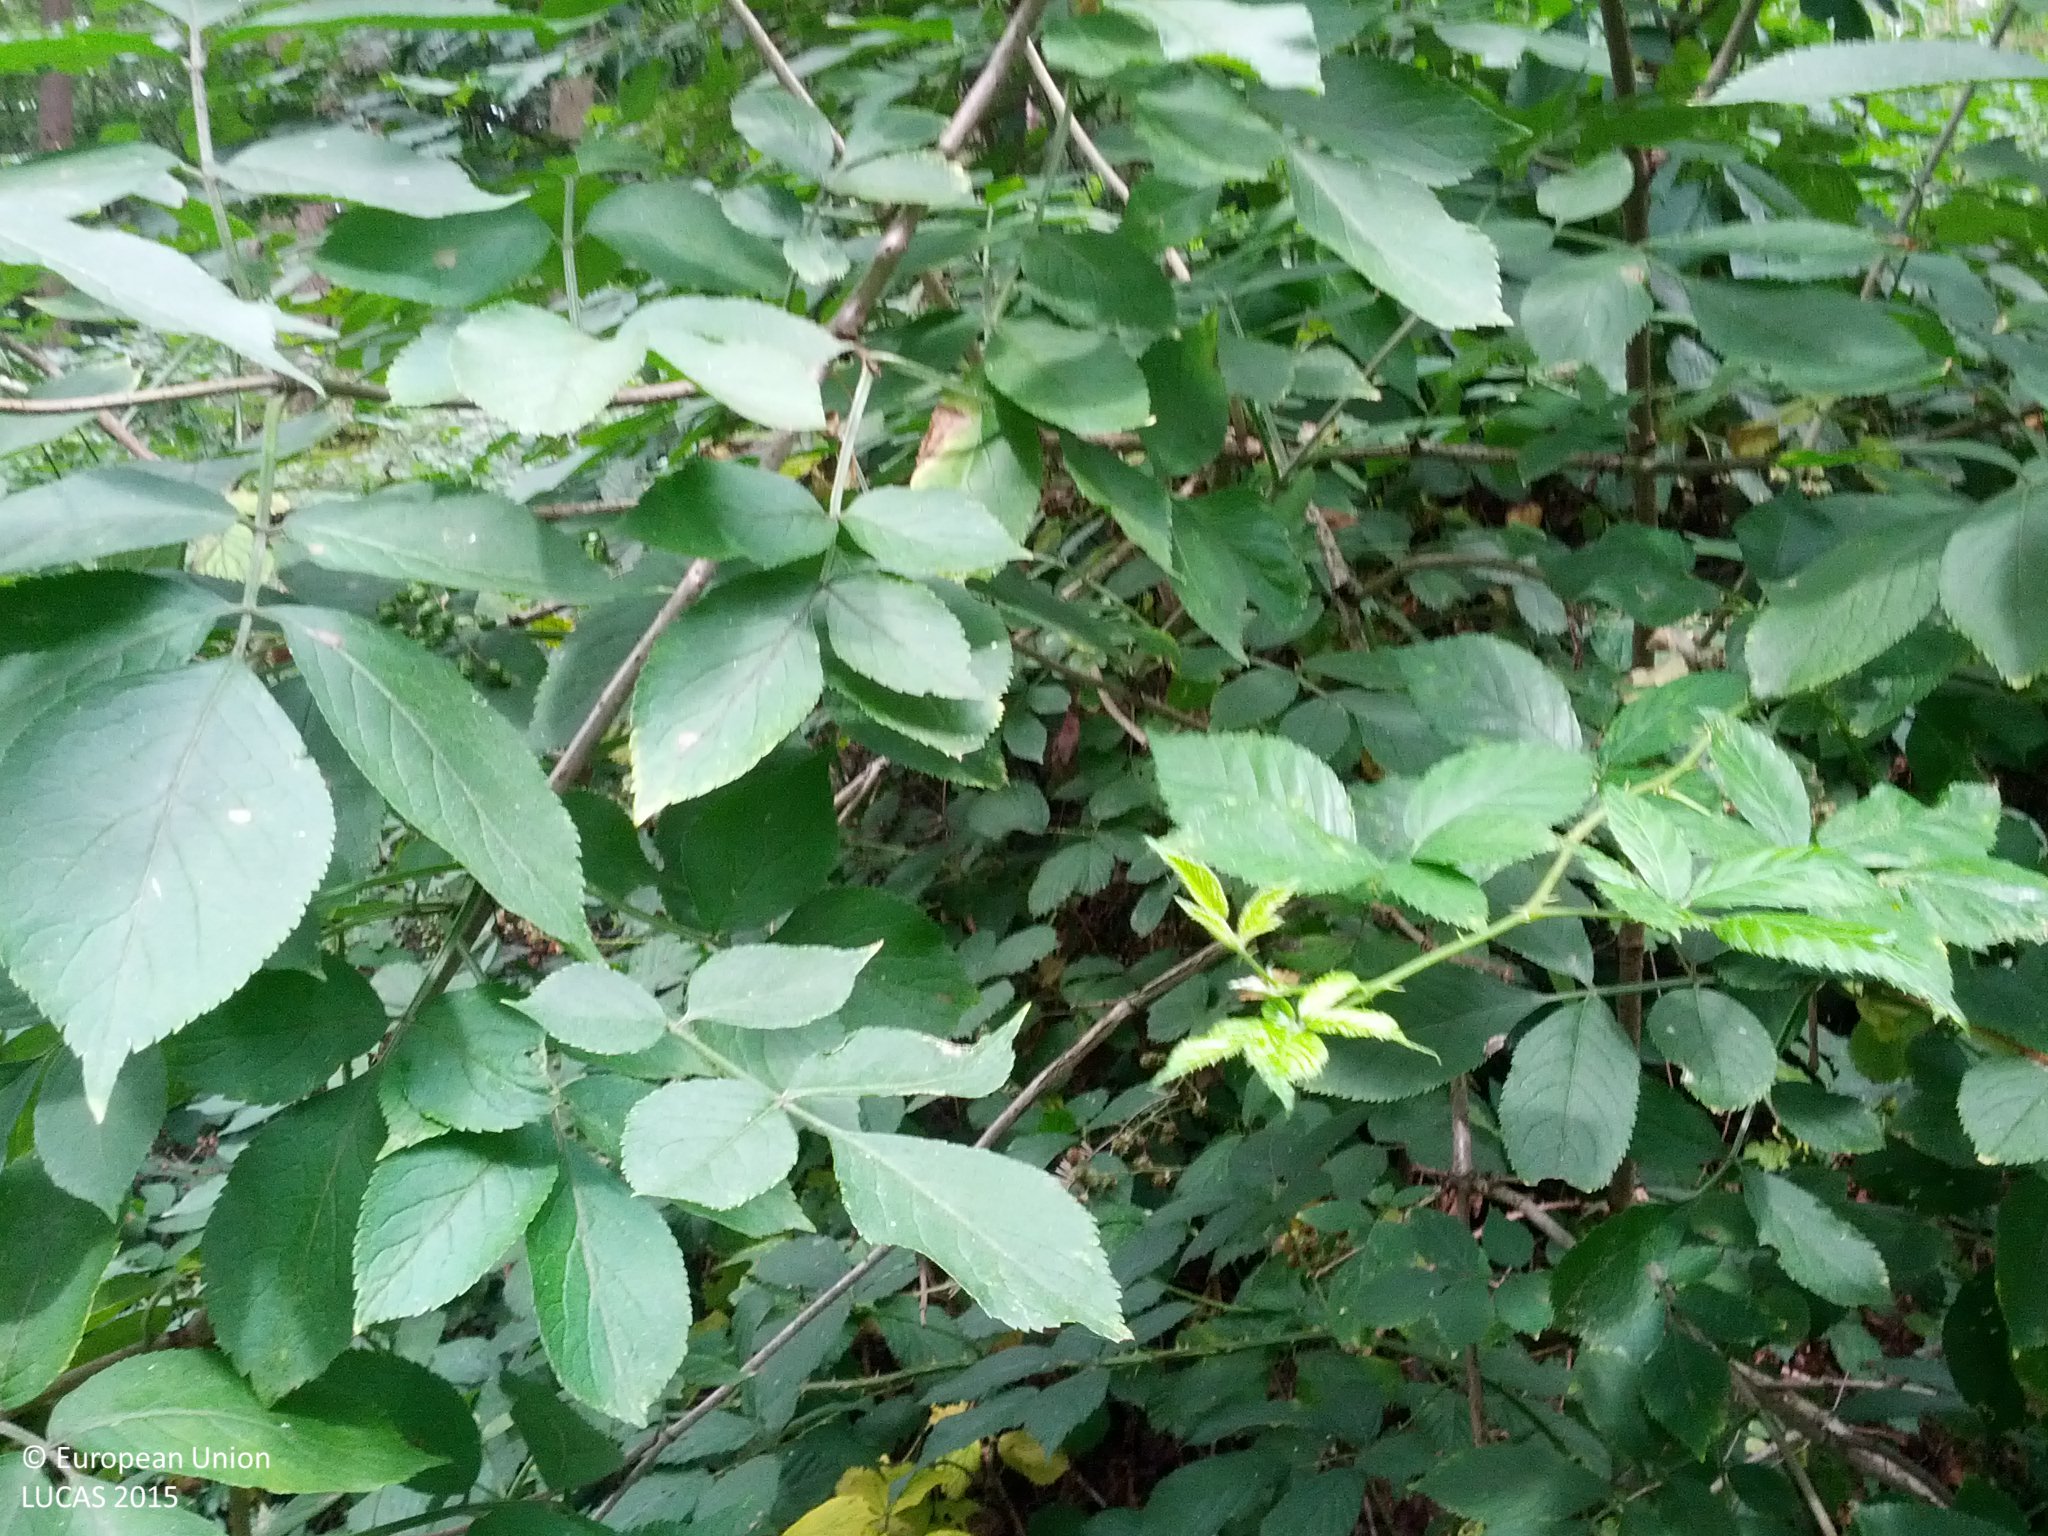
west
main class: Woodland
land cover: Pine dominated coniferous woodland
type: hemiboreal forest and nemoral coniferous forest and mixed broadleaved-coniferous forest
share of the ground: 50 - 75 %
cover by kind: coniferous forest trees 70 %, shrubs 20 %, herbaceous plants 10 %
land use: Forestry
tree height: > 5 m
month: July
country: AT
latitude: 48.5232
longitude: 16.1111
